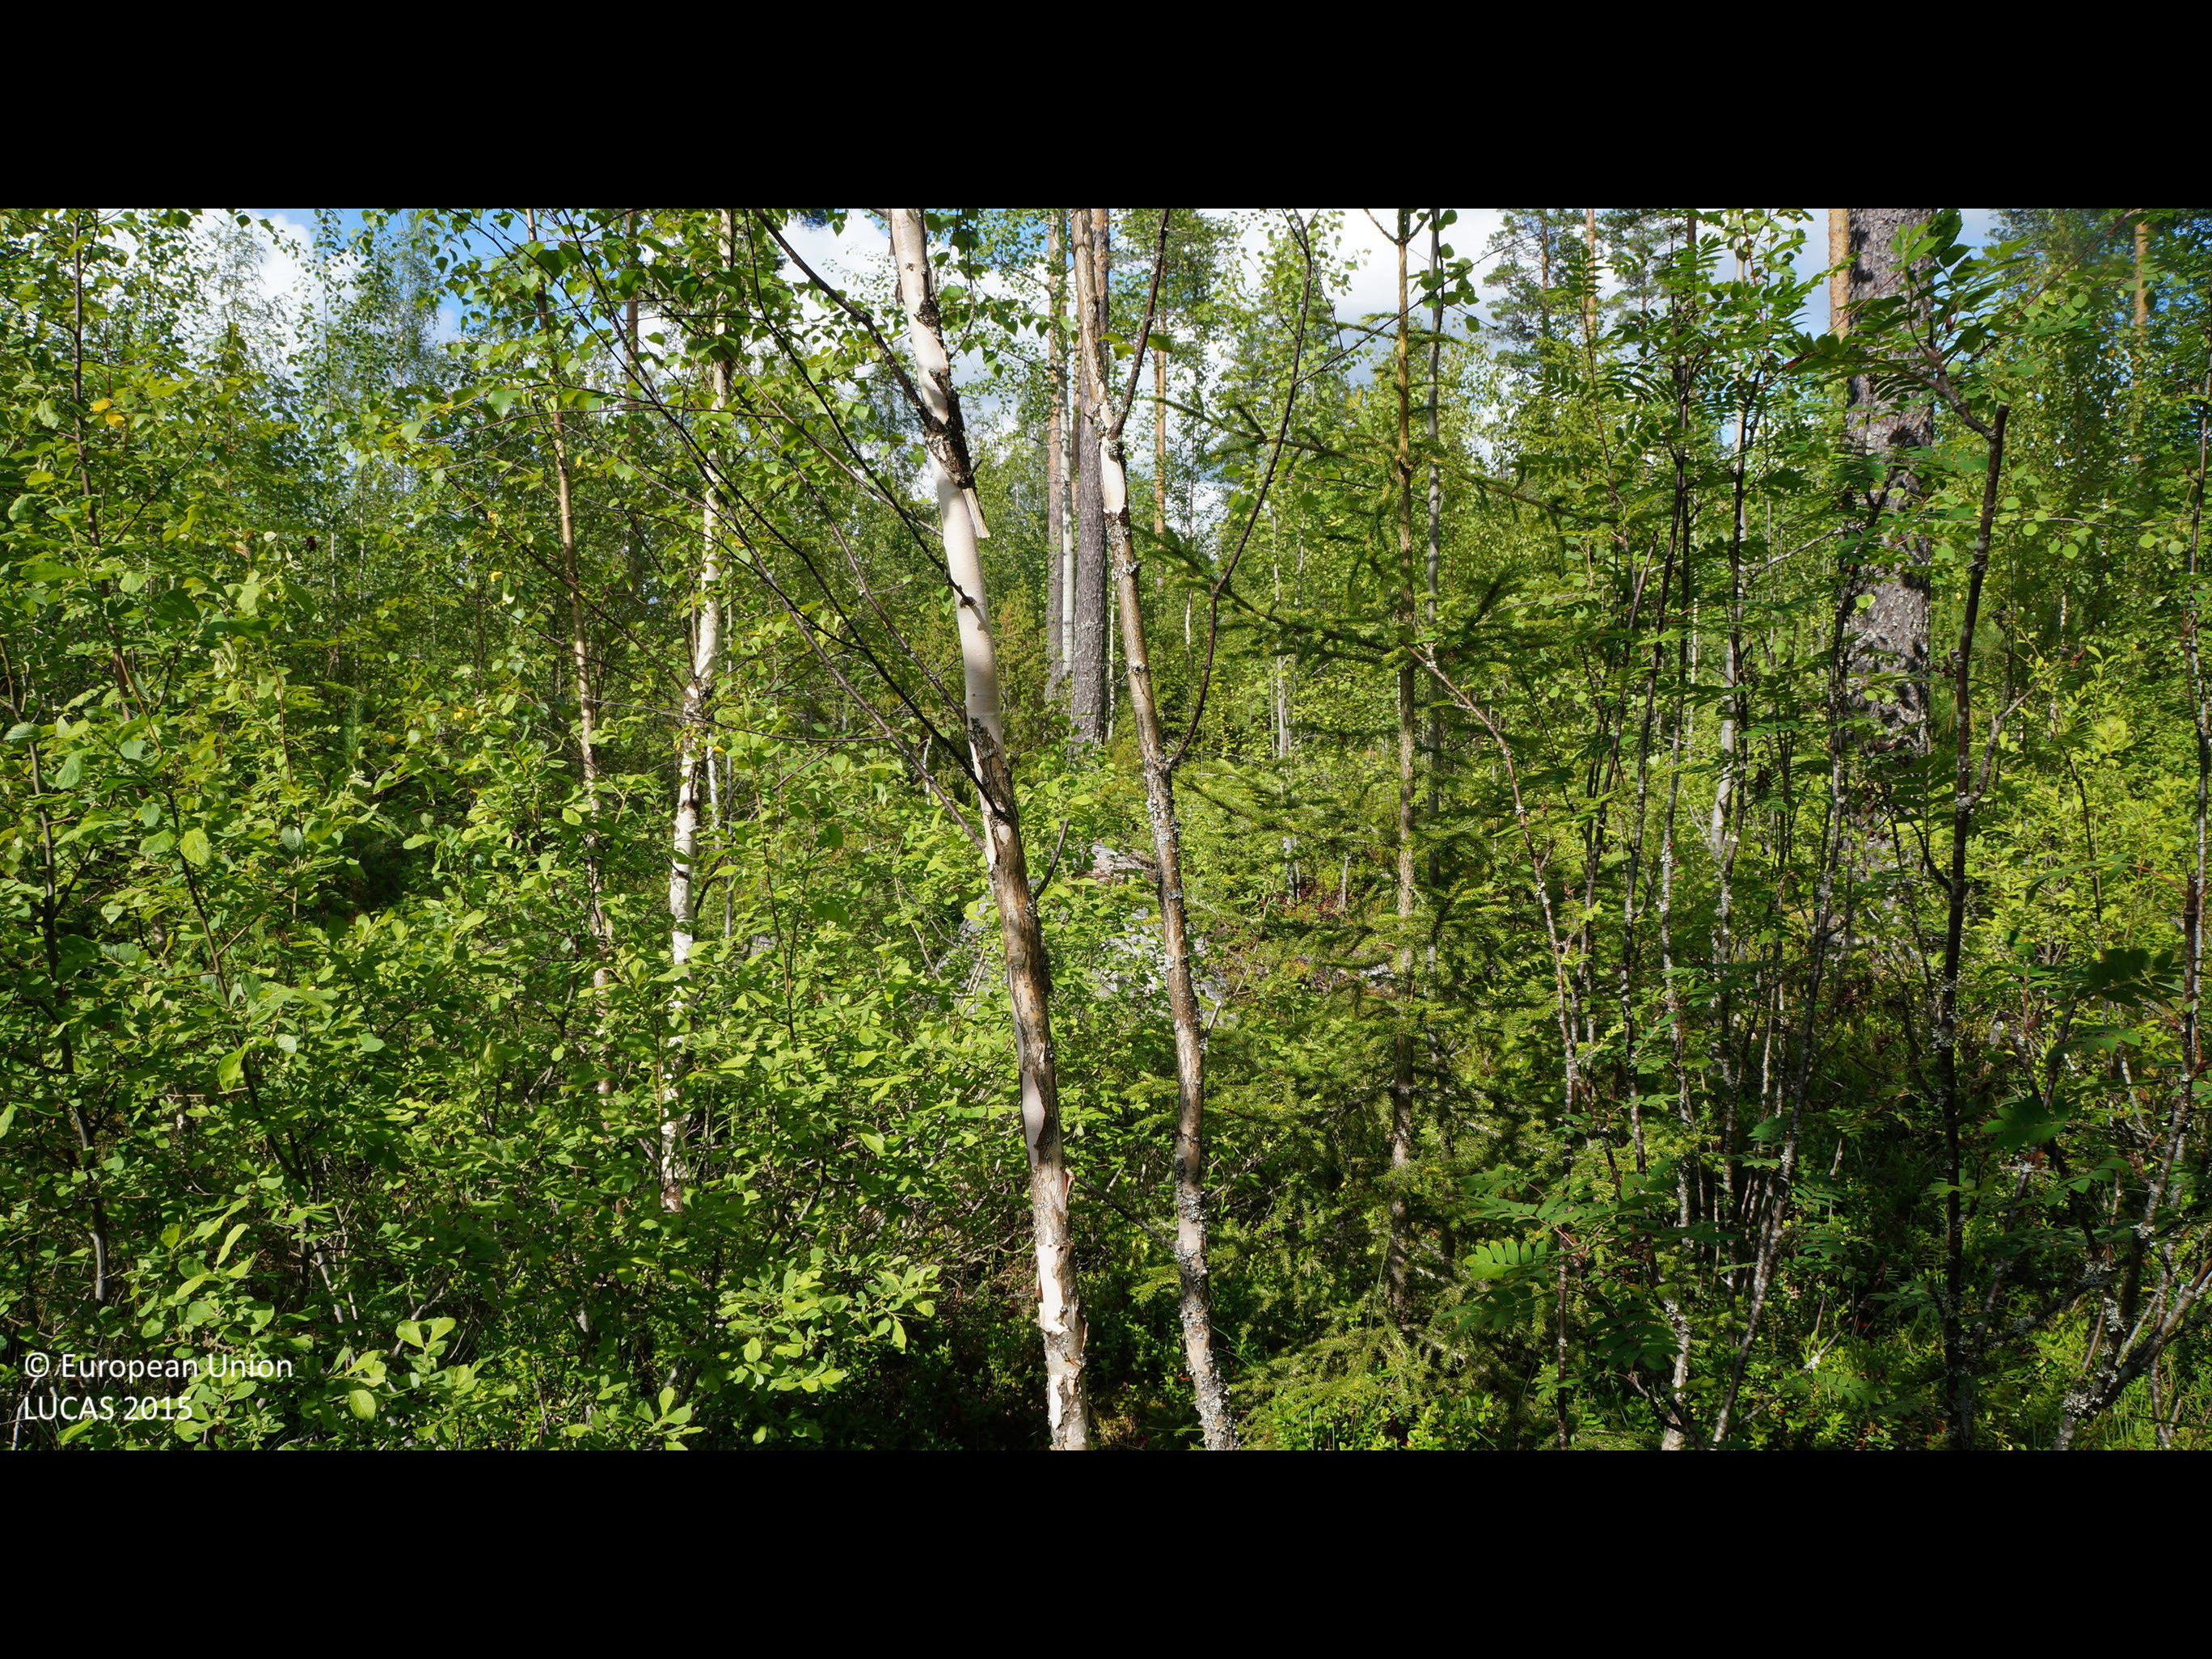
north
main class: Woodland
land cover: Pine dominated mixed woodland
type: boreal forest
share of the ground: 50 - 75 %
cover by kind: shrubs 40 %, coniferous forest trees 25 %, broadleaved forest trees 25 %, herbaceous plants 5 %, lichens and mosses 5 %
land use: Forestry
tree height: > 5 m
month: July
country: FI
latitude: 64.0018
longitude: 24.3229
